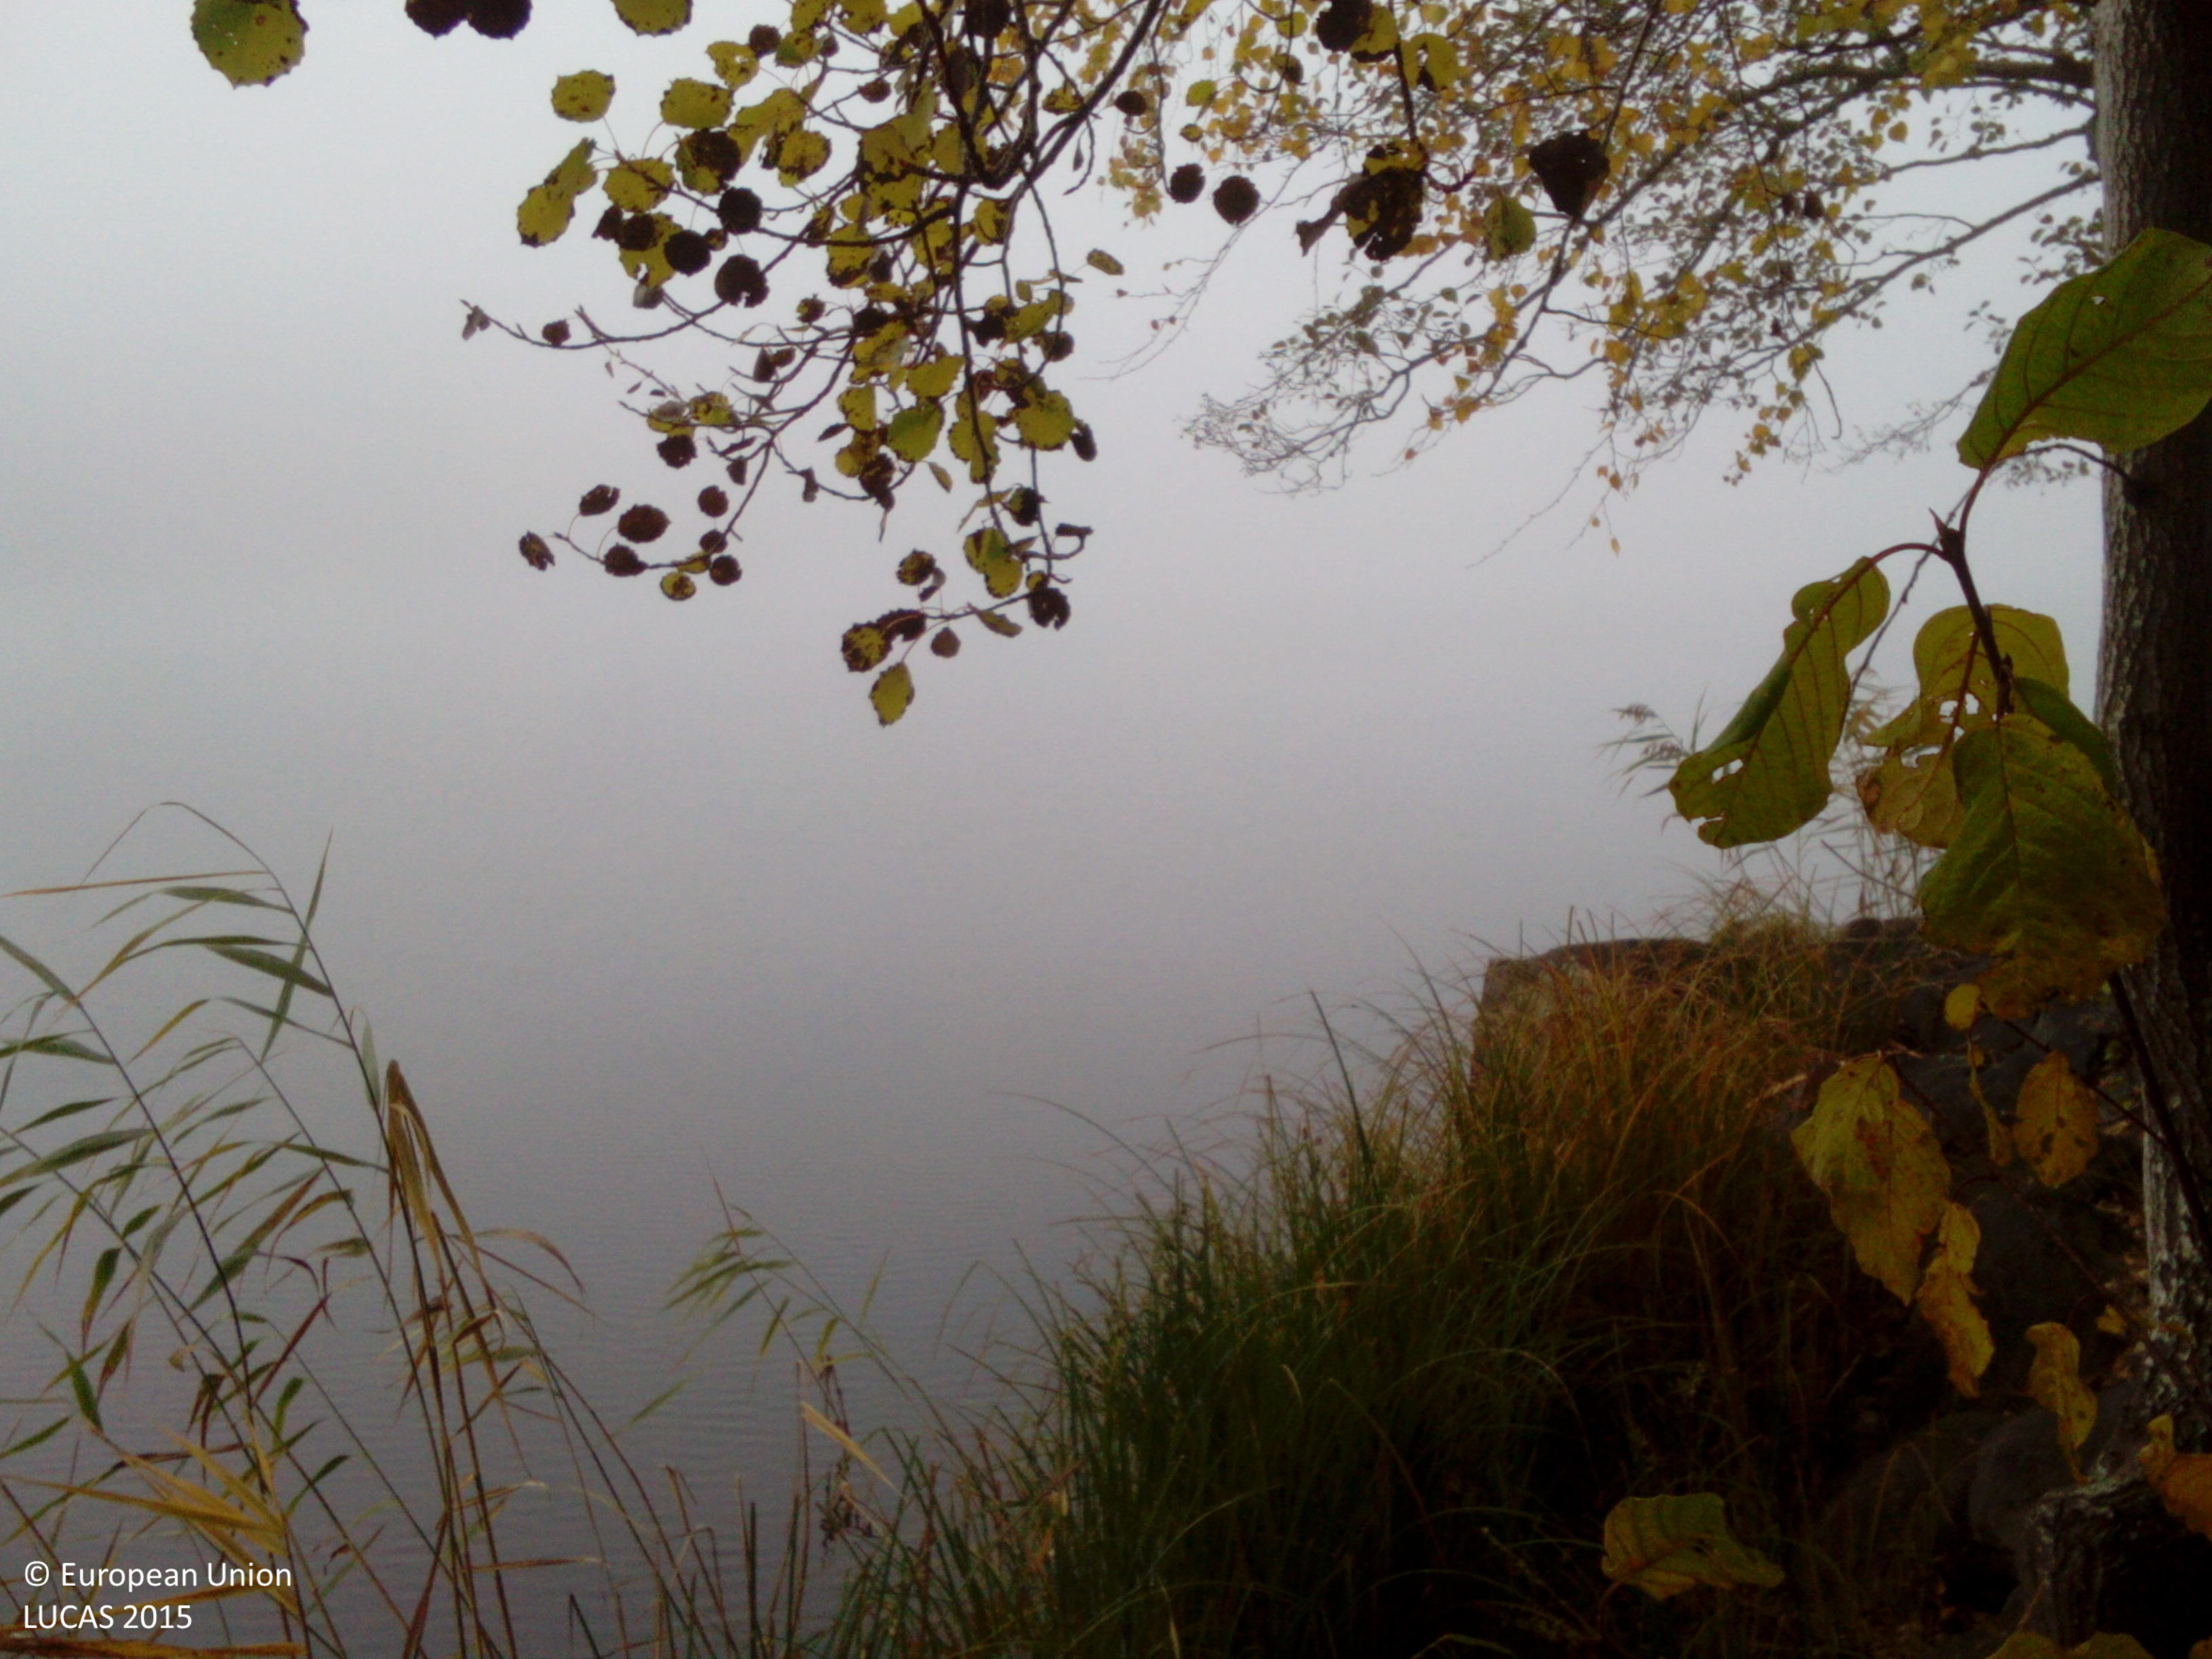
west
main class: Woodland
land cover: Pine dominated coniferous woodland
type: boreal forest
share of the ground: 25 - 50 %
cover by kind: coniferous forest trees 45 %
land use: Forestry
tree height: > 5 m
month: October
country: SE
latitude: 58.9448
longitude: 16.5468
